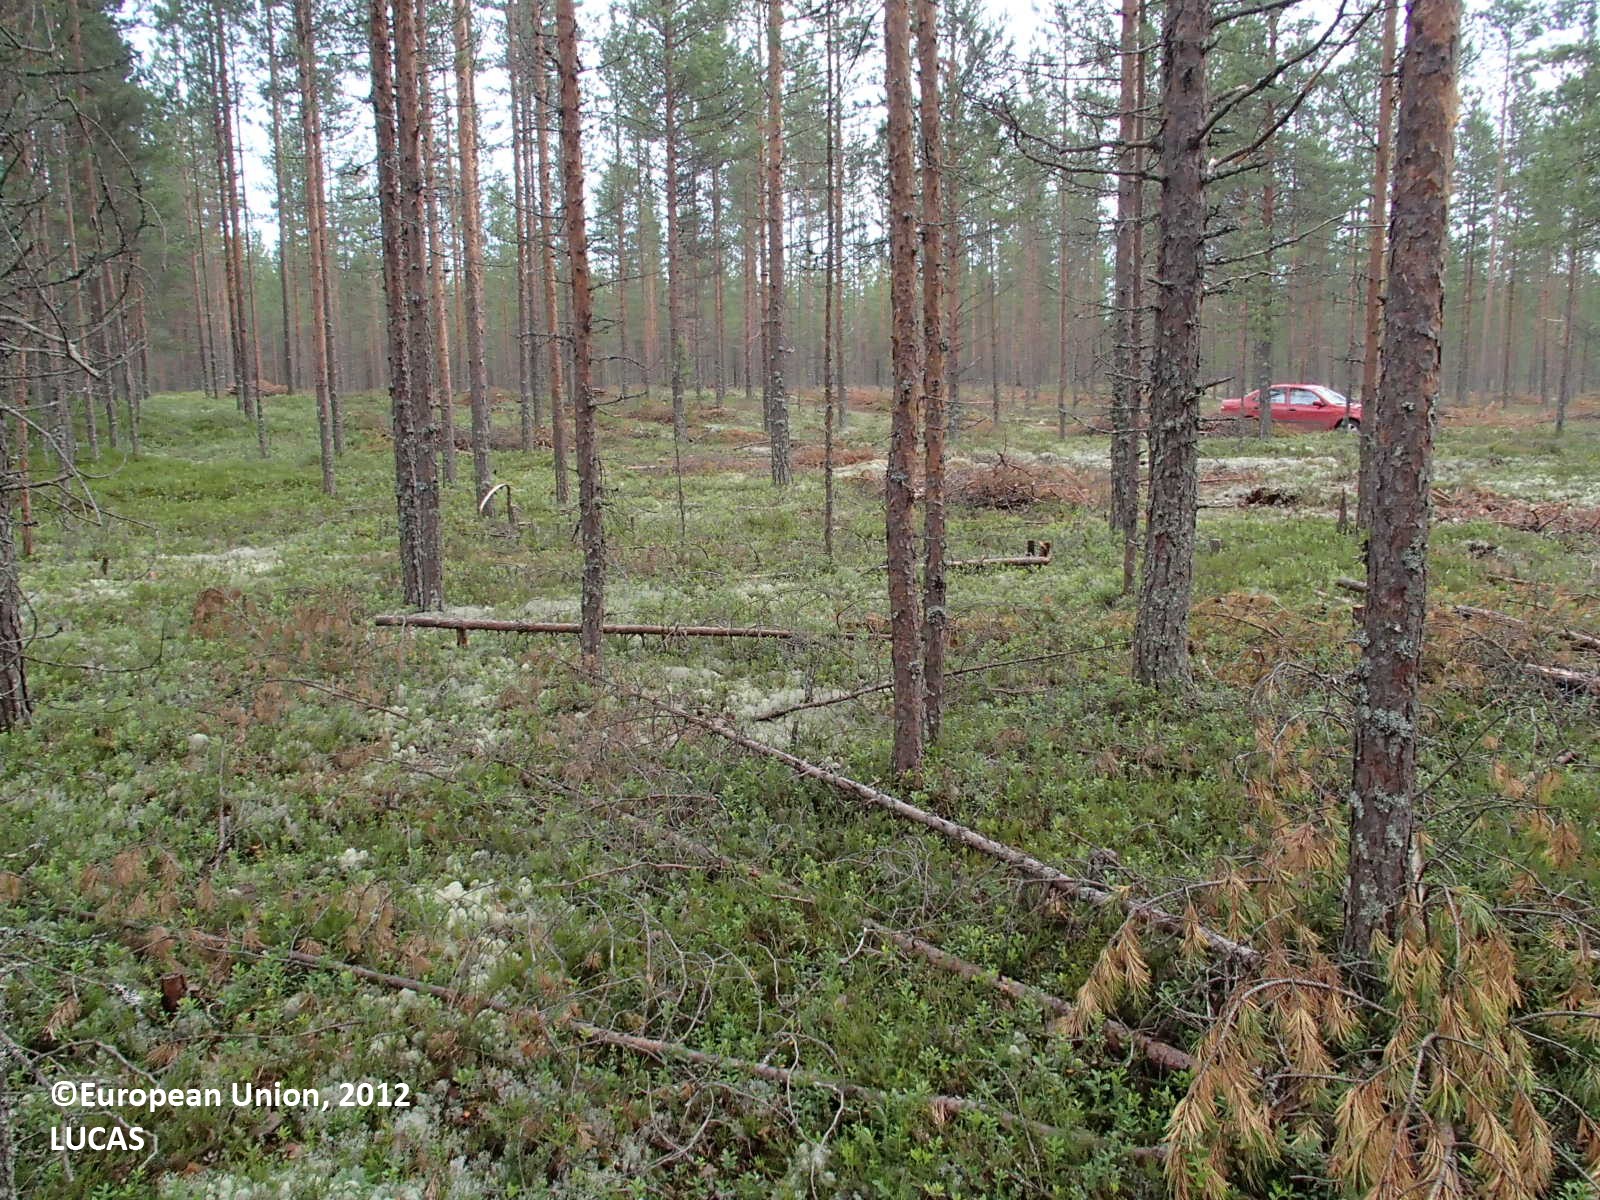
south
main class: Woodland
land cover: Pine dominated coniferous woodland
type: boreal forest
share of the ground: 50 - 75 %
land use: Forestry
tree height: > 5 m
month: July
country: FI
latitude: 64.3241
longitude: 26.3086
